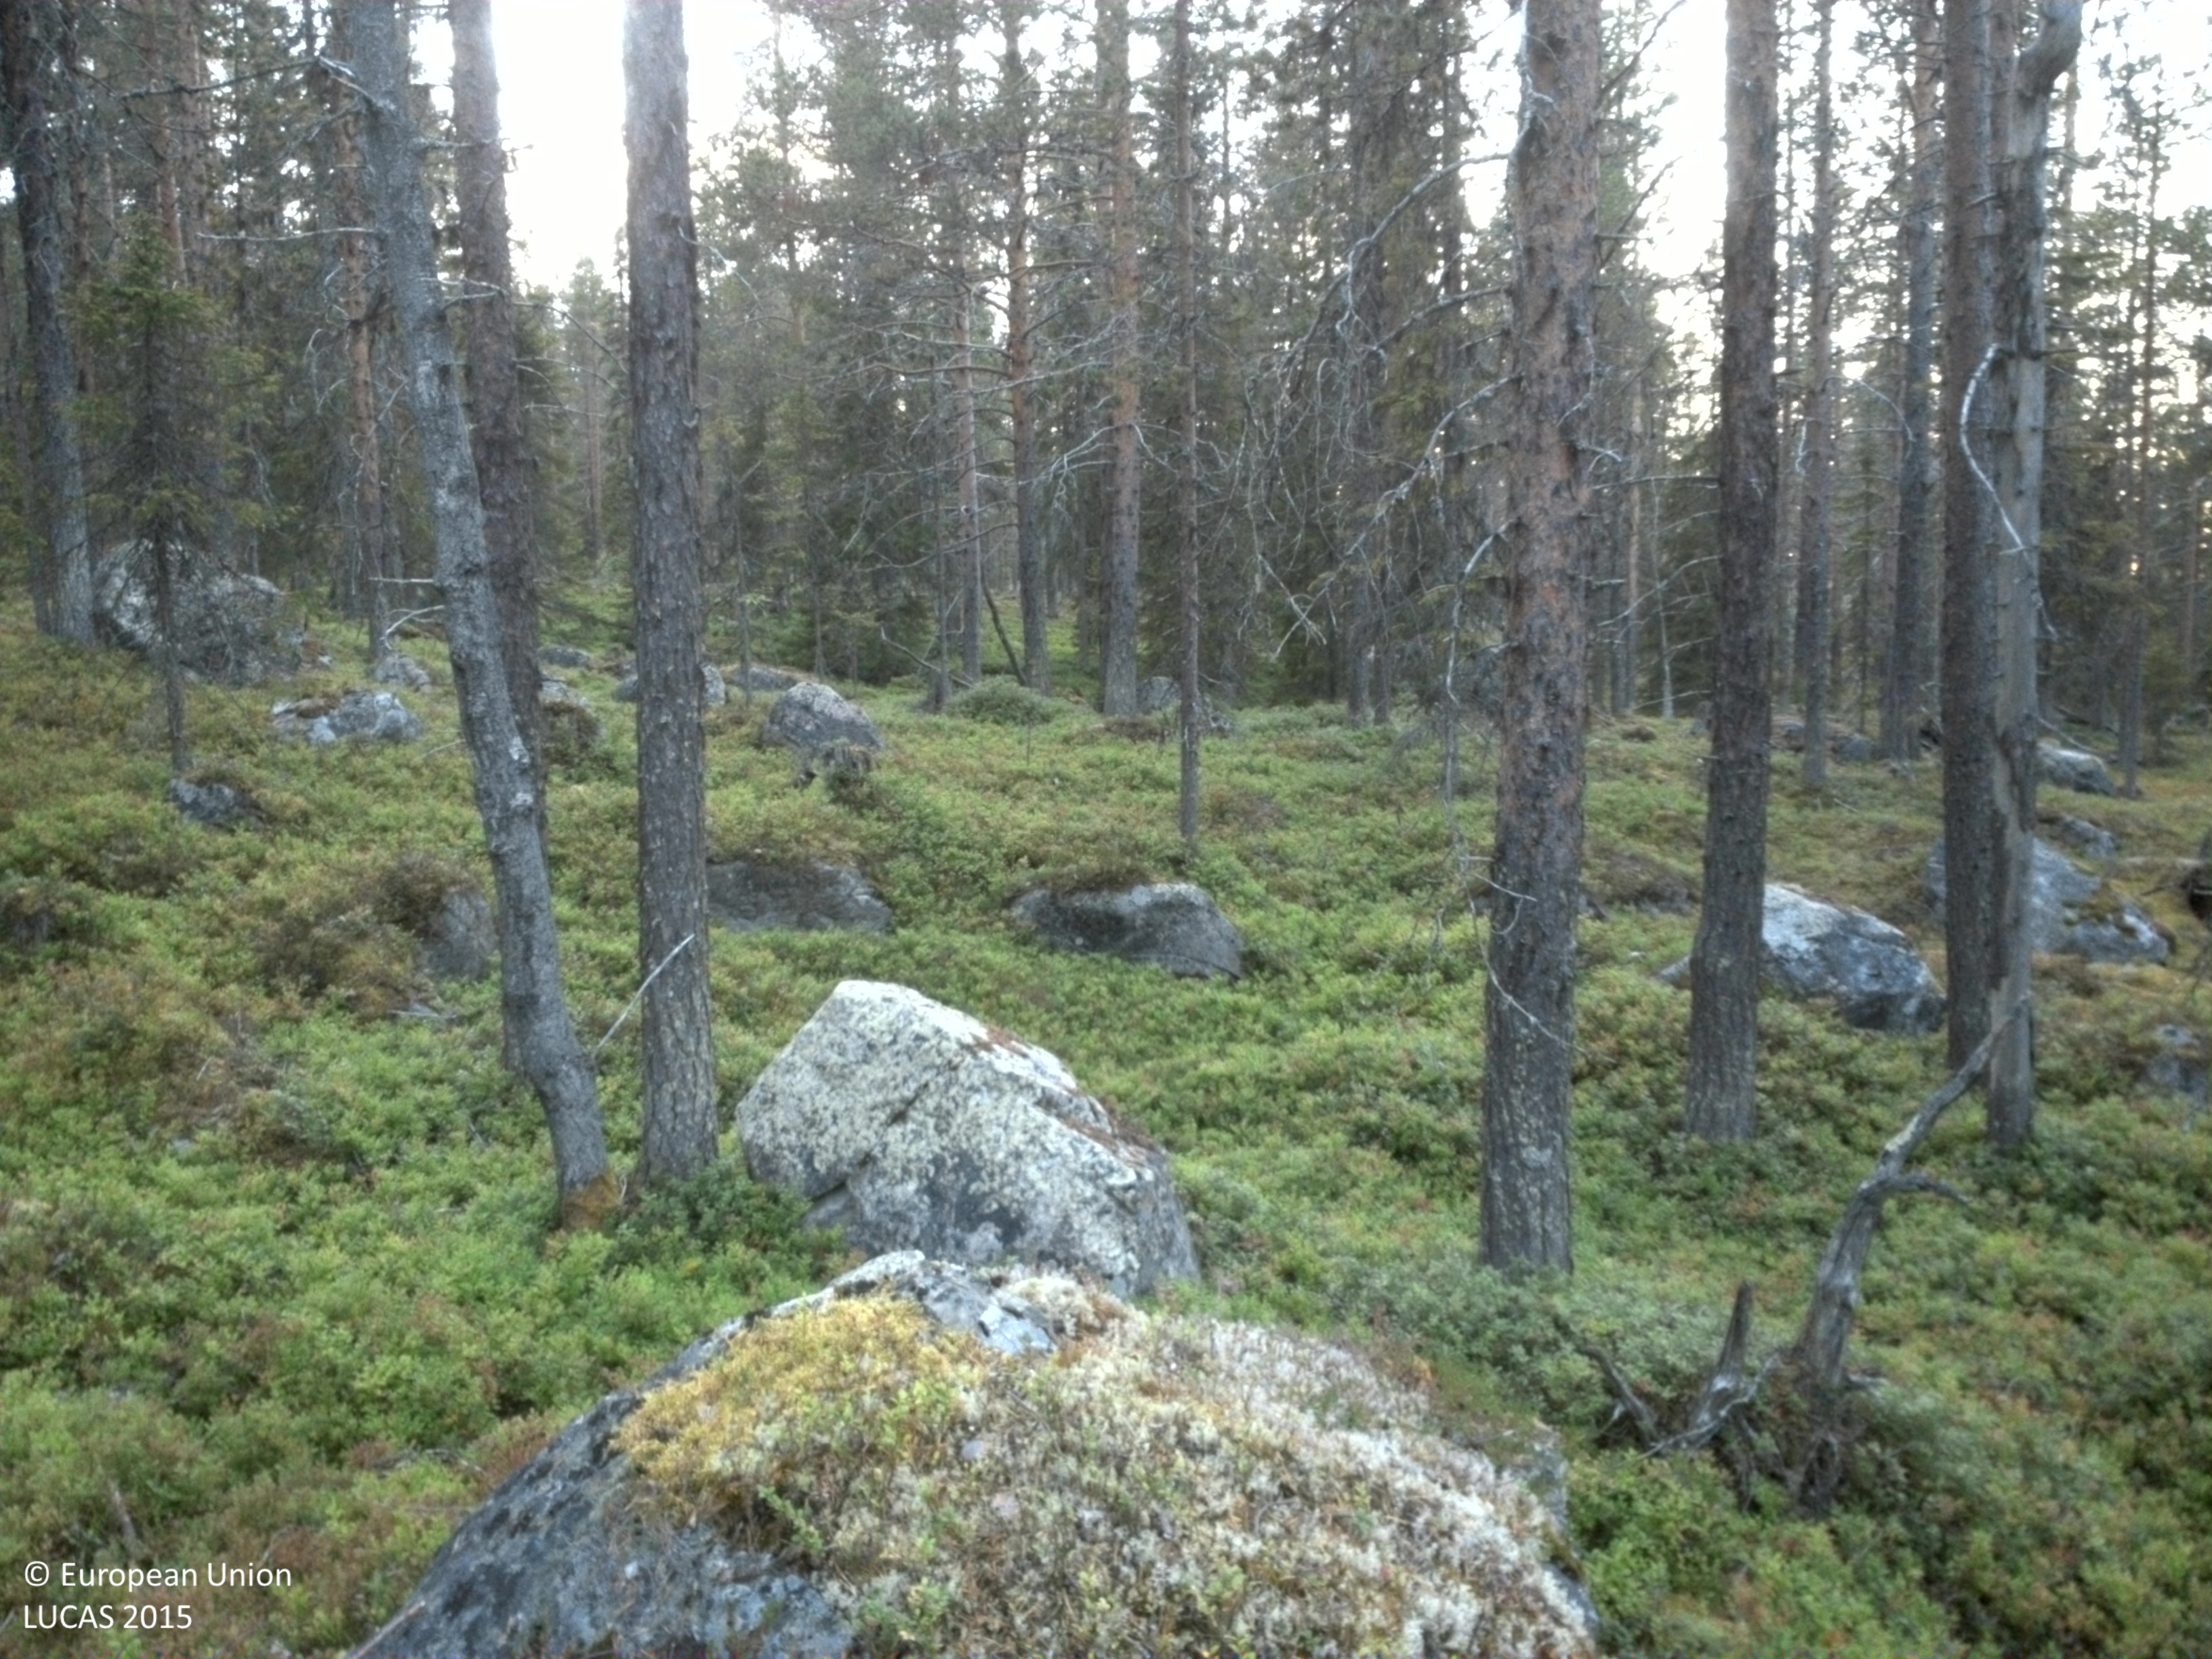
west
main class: Woodland
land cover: Pine dominated coniferous woodland
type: boreal forest
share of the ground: 10 - 25 %
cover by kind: shrubs 65 %, coniferous forest trees 20 %, lichens and mosses 10 %, consolidated bare surface 5 %
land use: Forestry
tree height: > 5 m
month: September
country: SE
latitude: 65.1613
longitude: 17.5791
